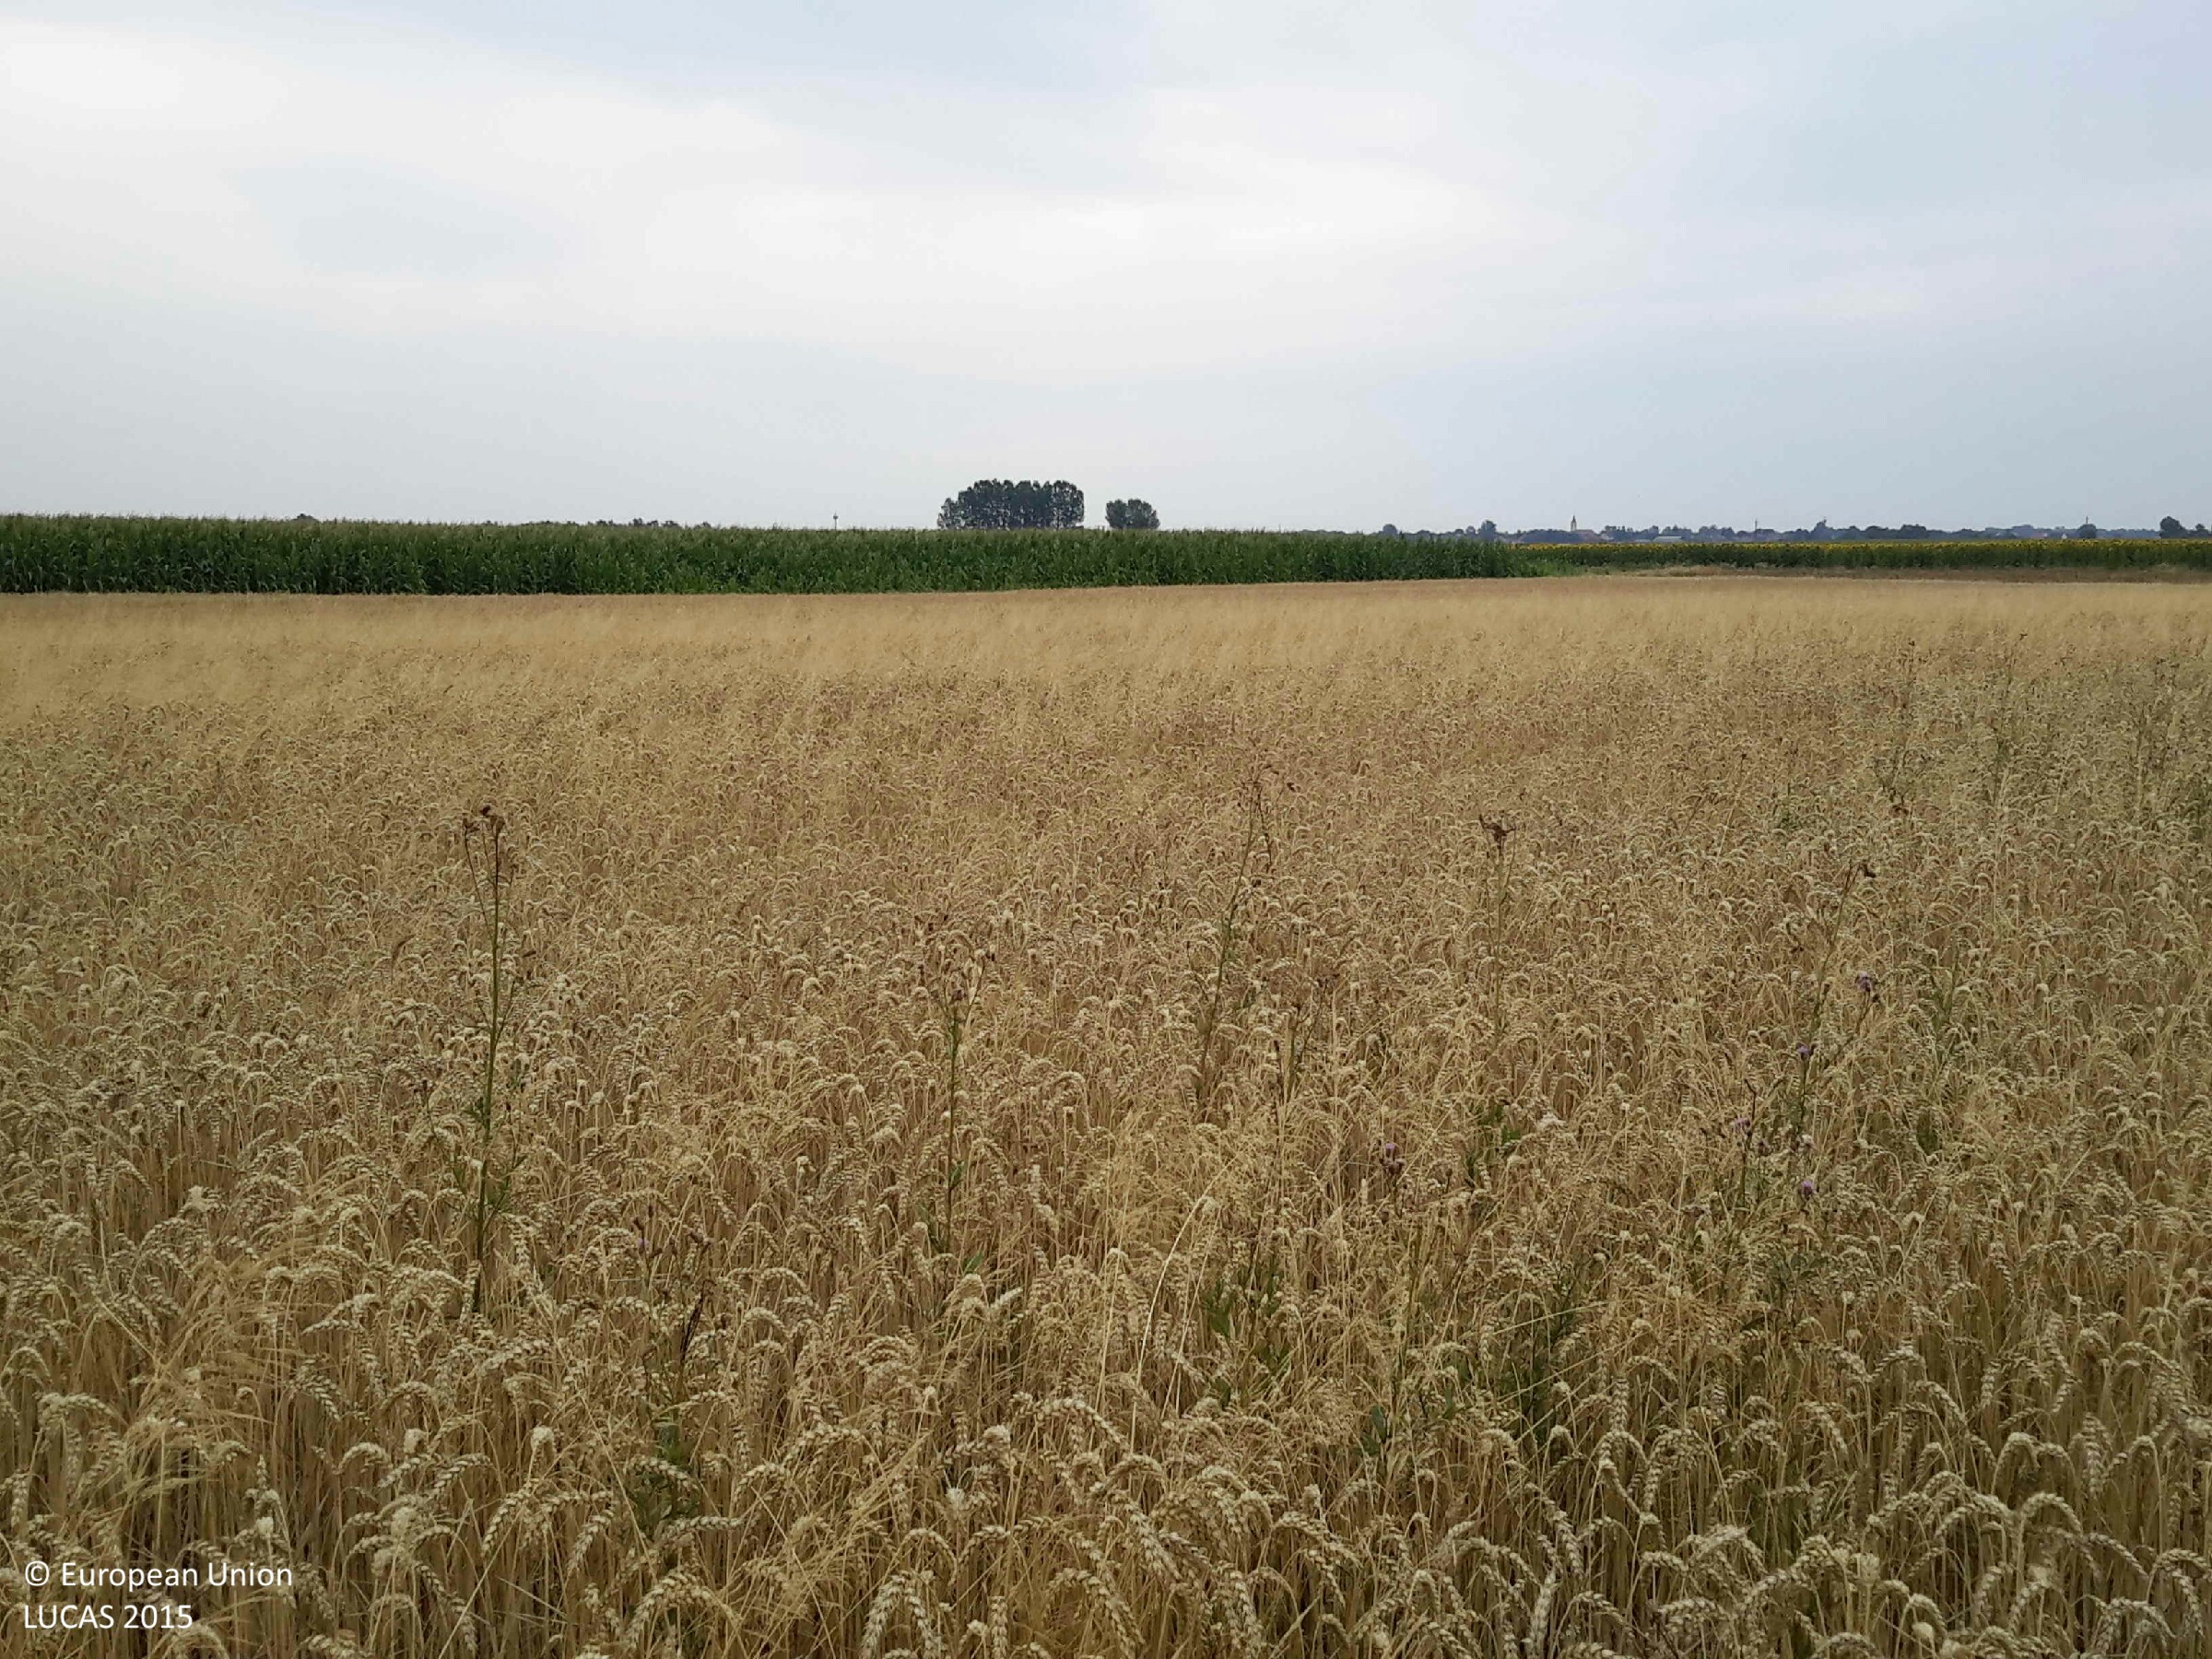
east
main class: Cropland
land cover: Common wheat
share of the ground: > 75 %
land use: Agriculture (excluding fallow land and kitchen gardens)
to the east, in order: Common wheat; Barley; Maize; Barley; Spontaneously vegetated surfaces; Grass margins; Sunflower
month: July
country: HU
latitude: 47.4362
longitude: 17.0730
